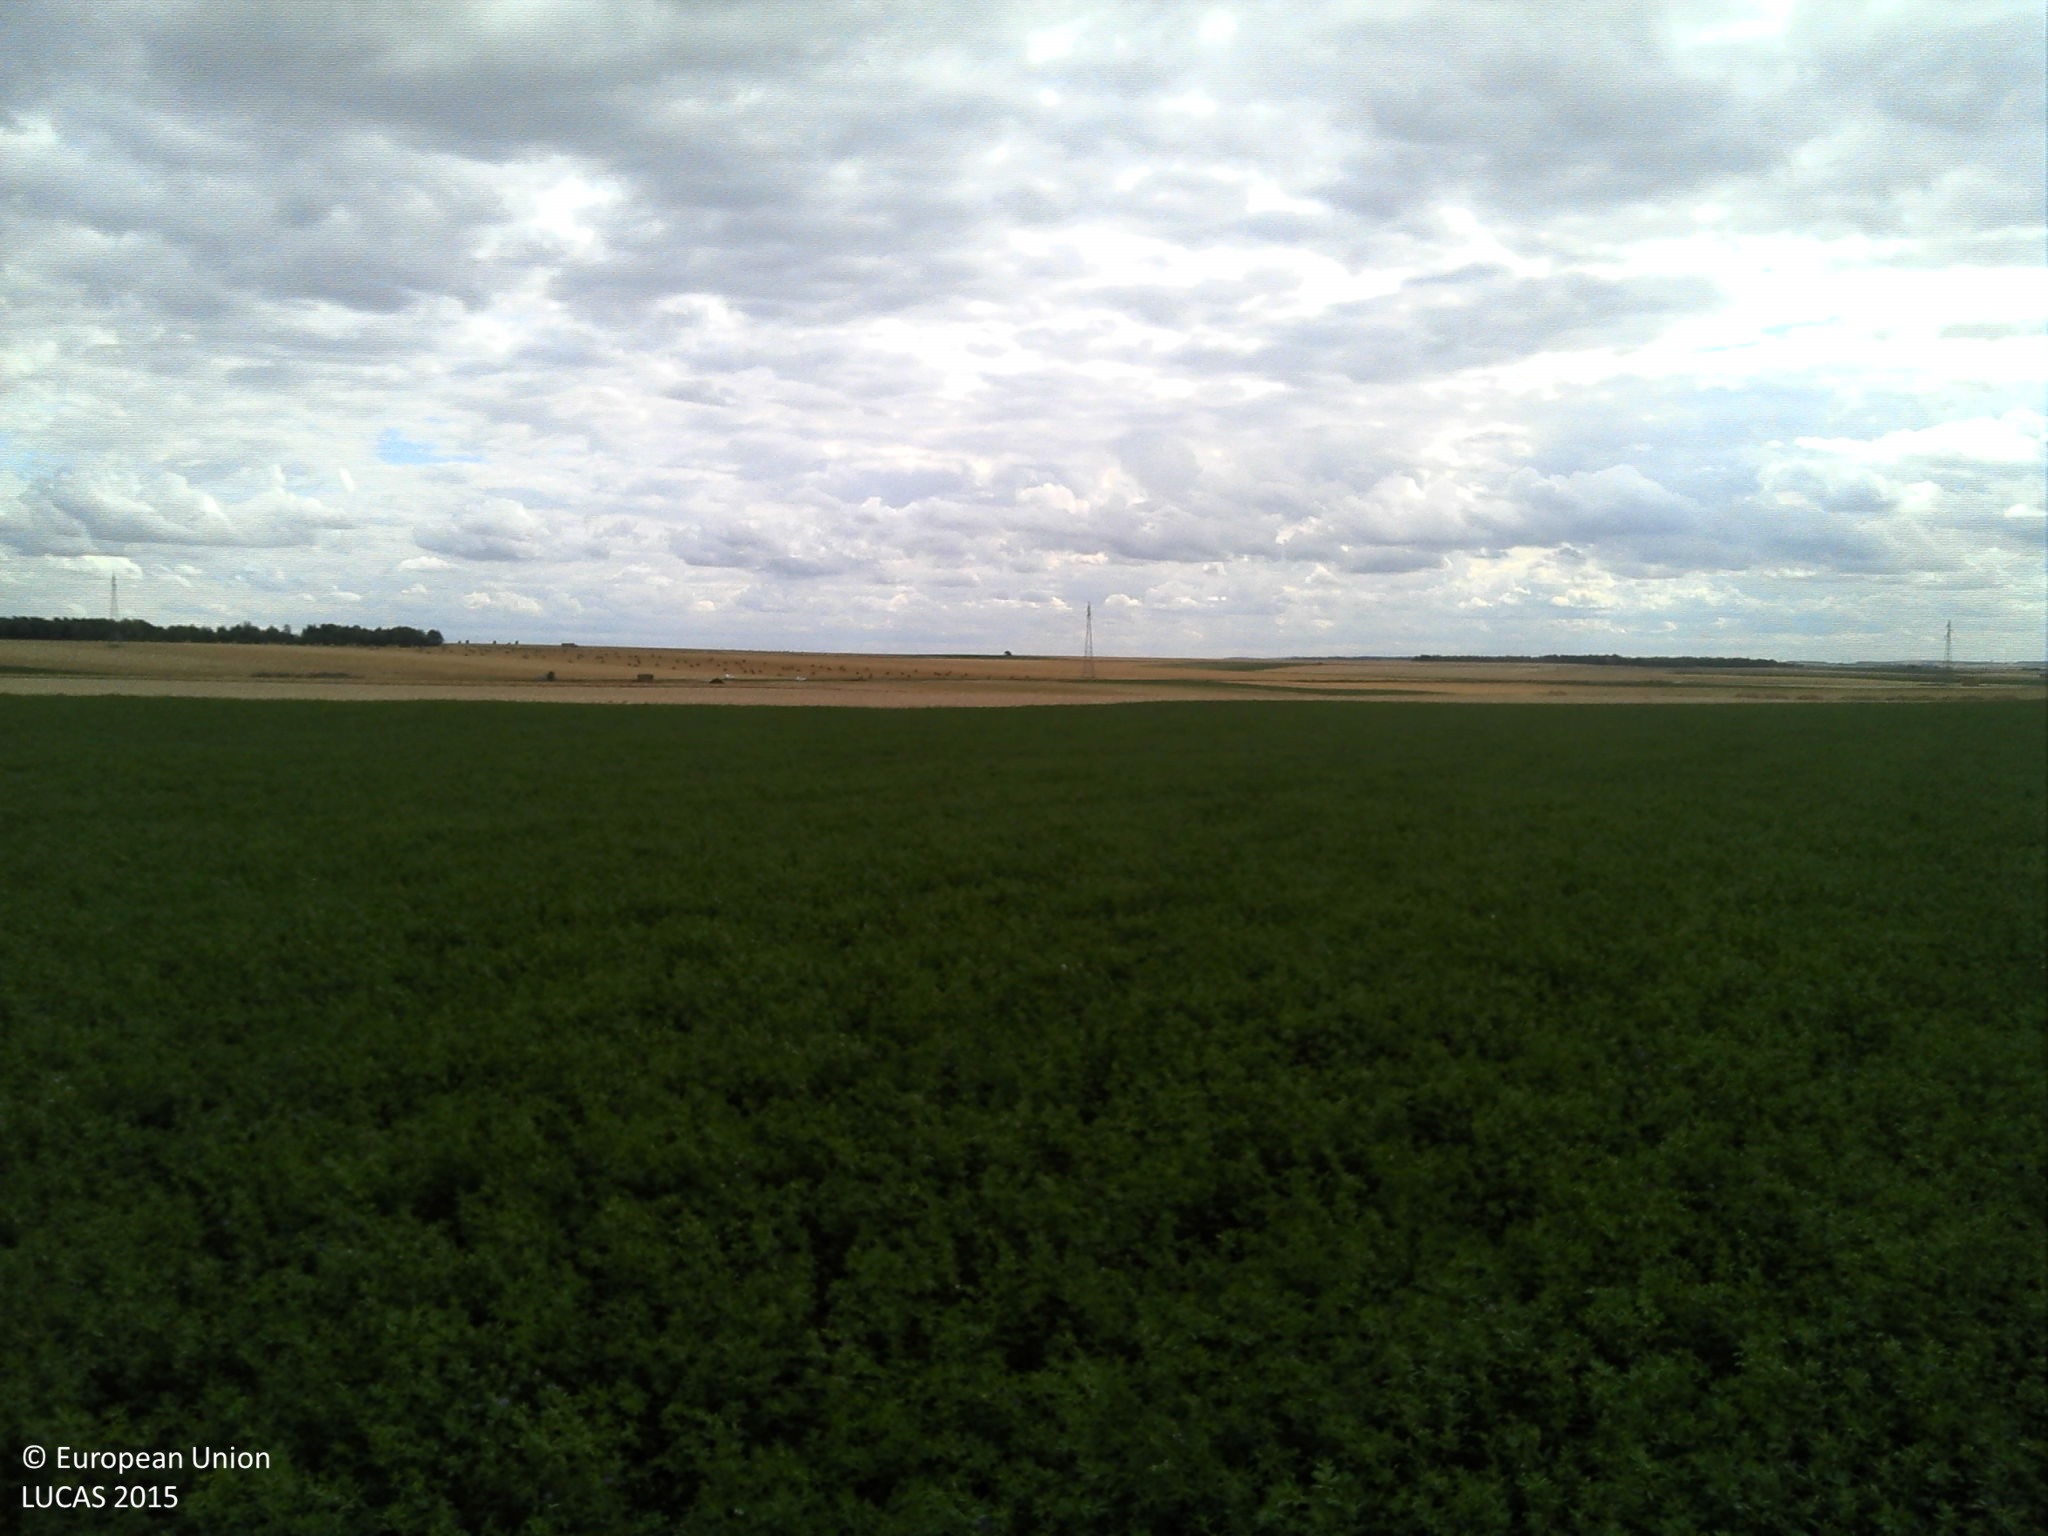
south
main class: Cropland
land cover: Lucerne
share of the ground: > 75 %
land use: Agriculture (excluding fallow land and kitchen gardens)
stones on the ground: < 10 %
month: July
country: FR
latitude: 49.4218
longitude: 4.5234
